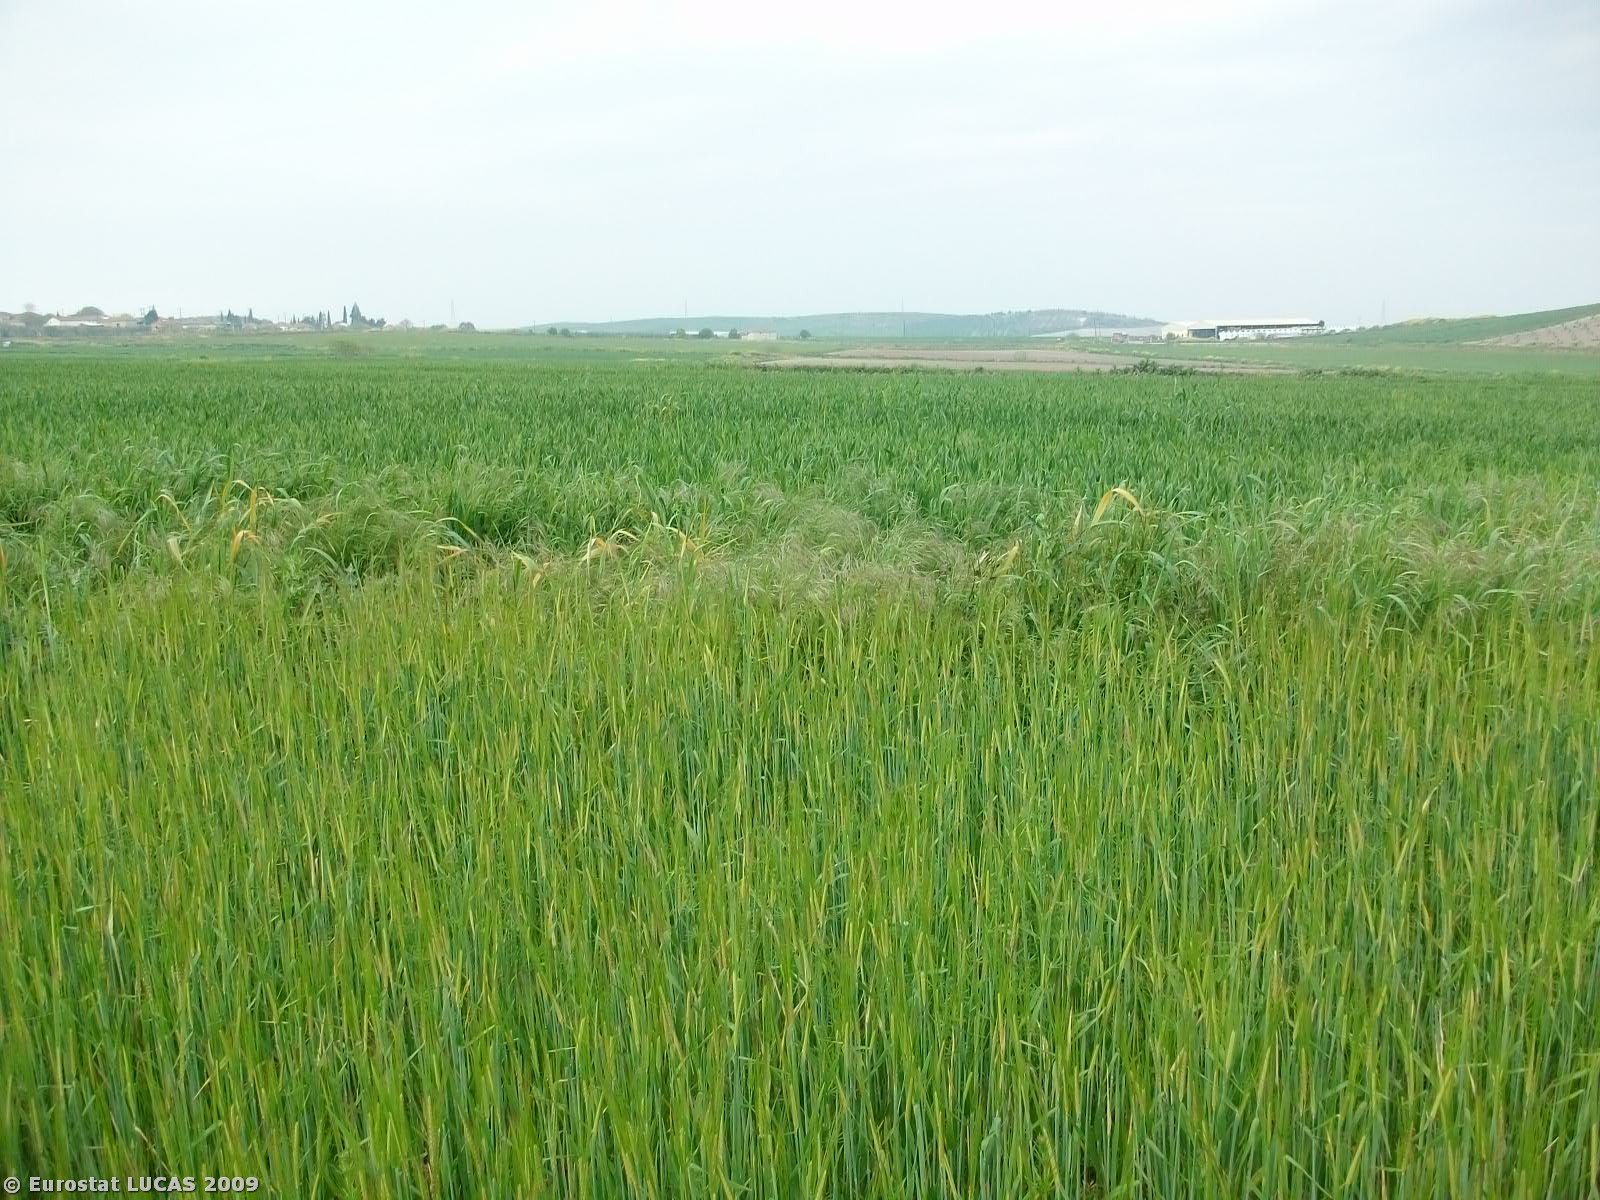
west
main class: Cropland
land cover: Common wheat
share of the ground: > 75 %
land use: Agriculture (excluding fallow land and kitchen gardens)
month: April
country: GR
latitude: 39.4577
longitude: 22.5521
